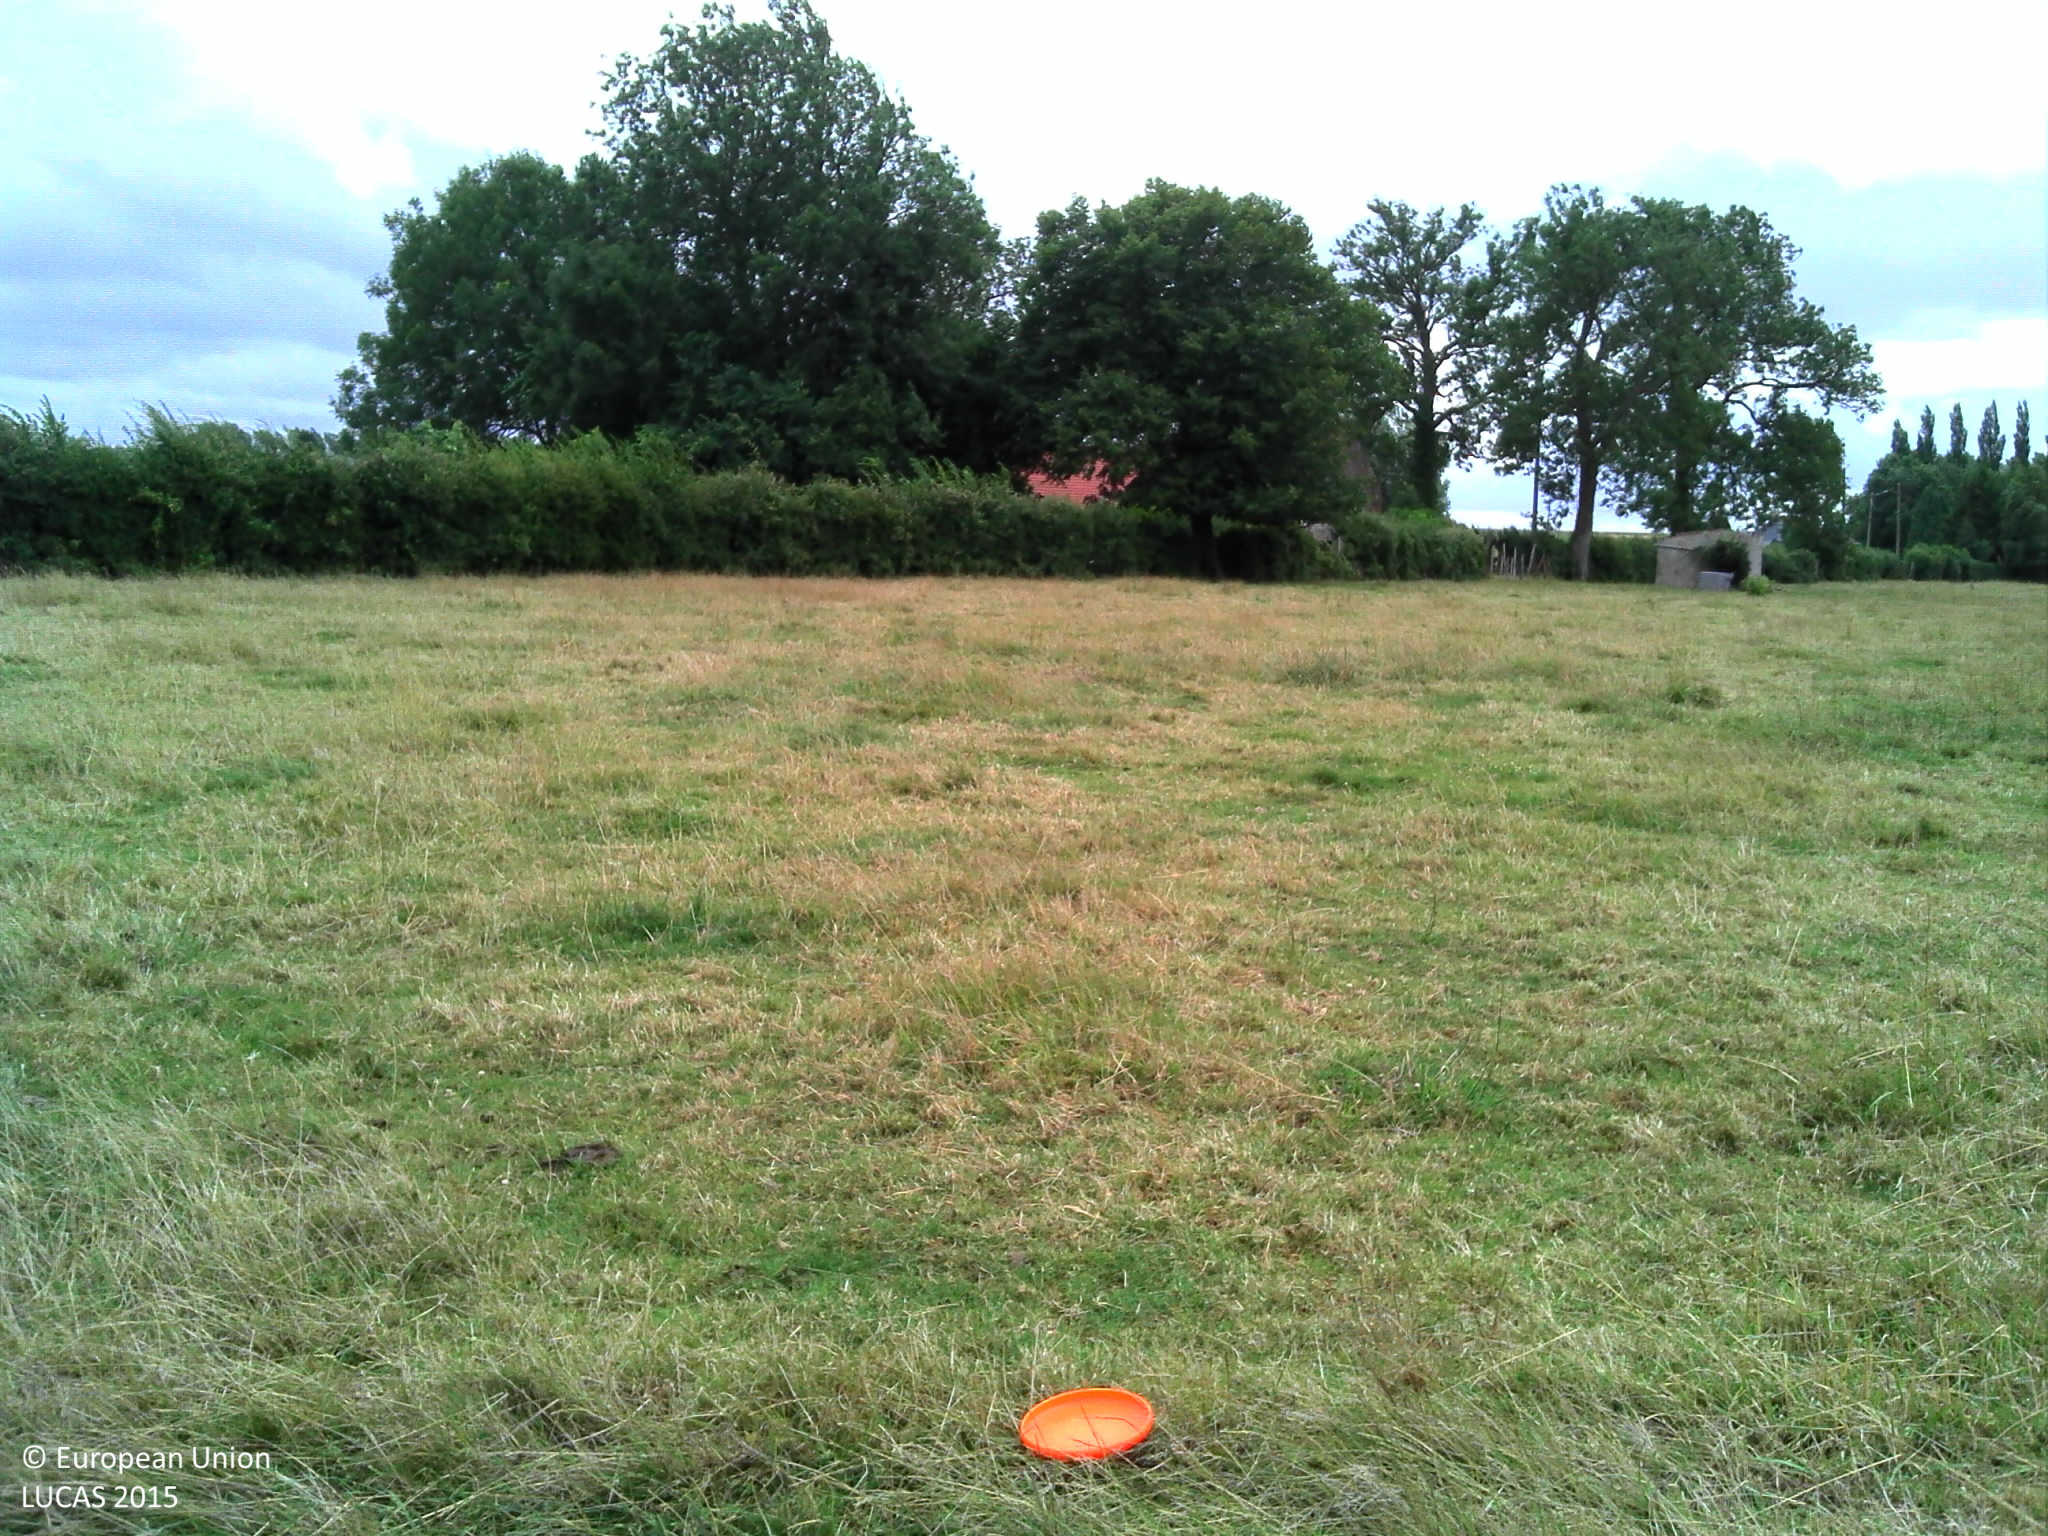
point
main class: Grassland
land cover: Grassland without tree/shrub cover
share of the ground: > 75 %
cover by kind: herbaceous plants 100 %
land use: Agriculture (excluding fallow land and kitchen gardens)
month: July
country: FR
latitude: 50.6709
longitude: 2.1320
